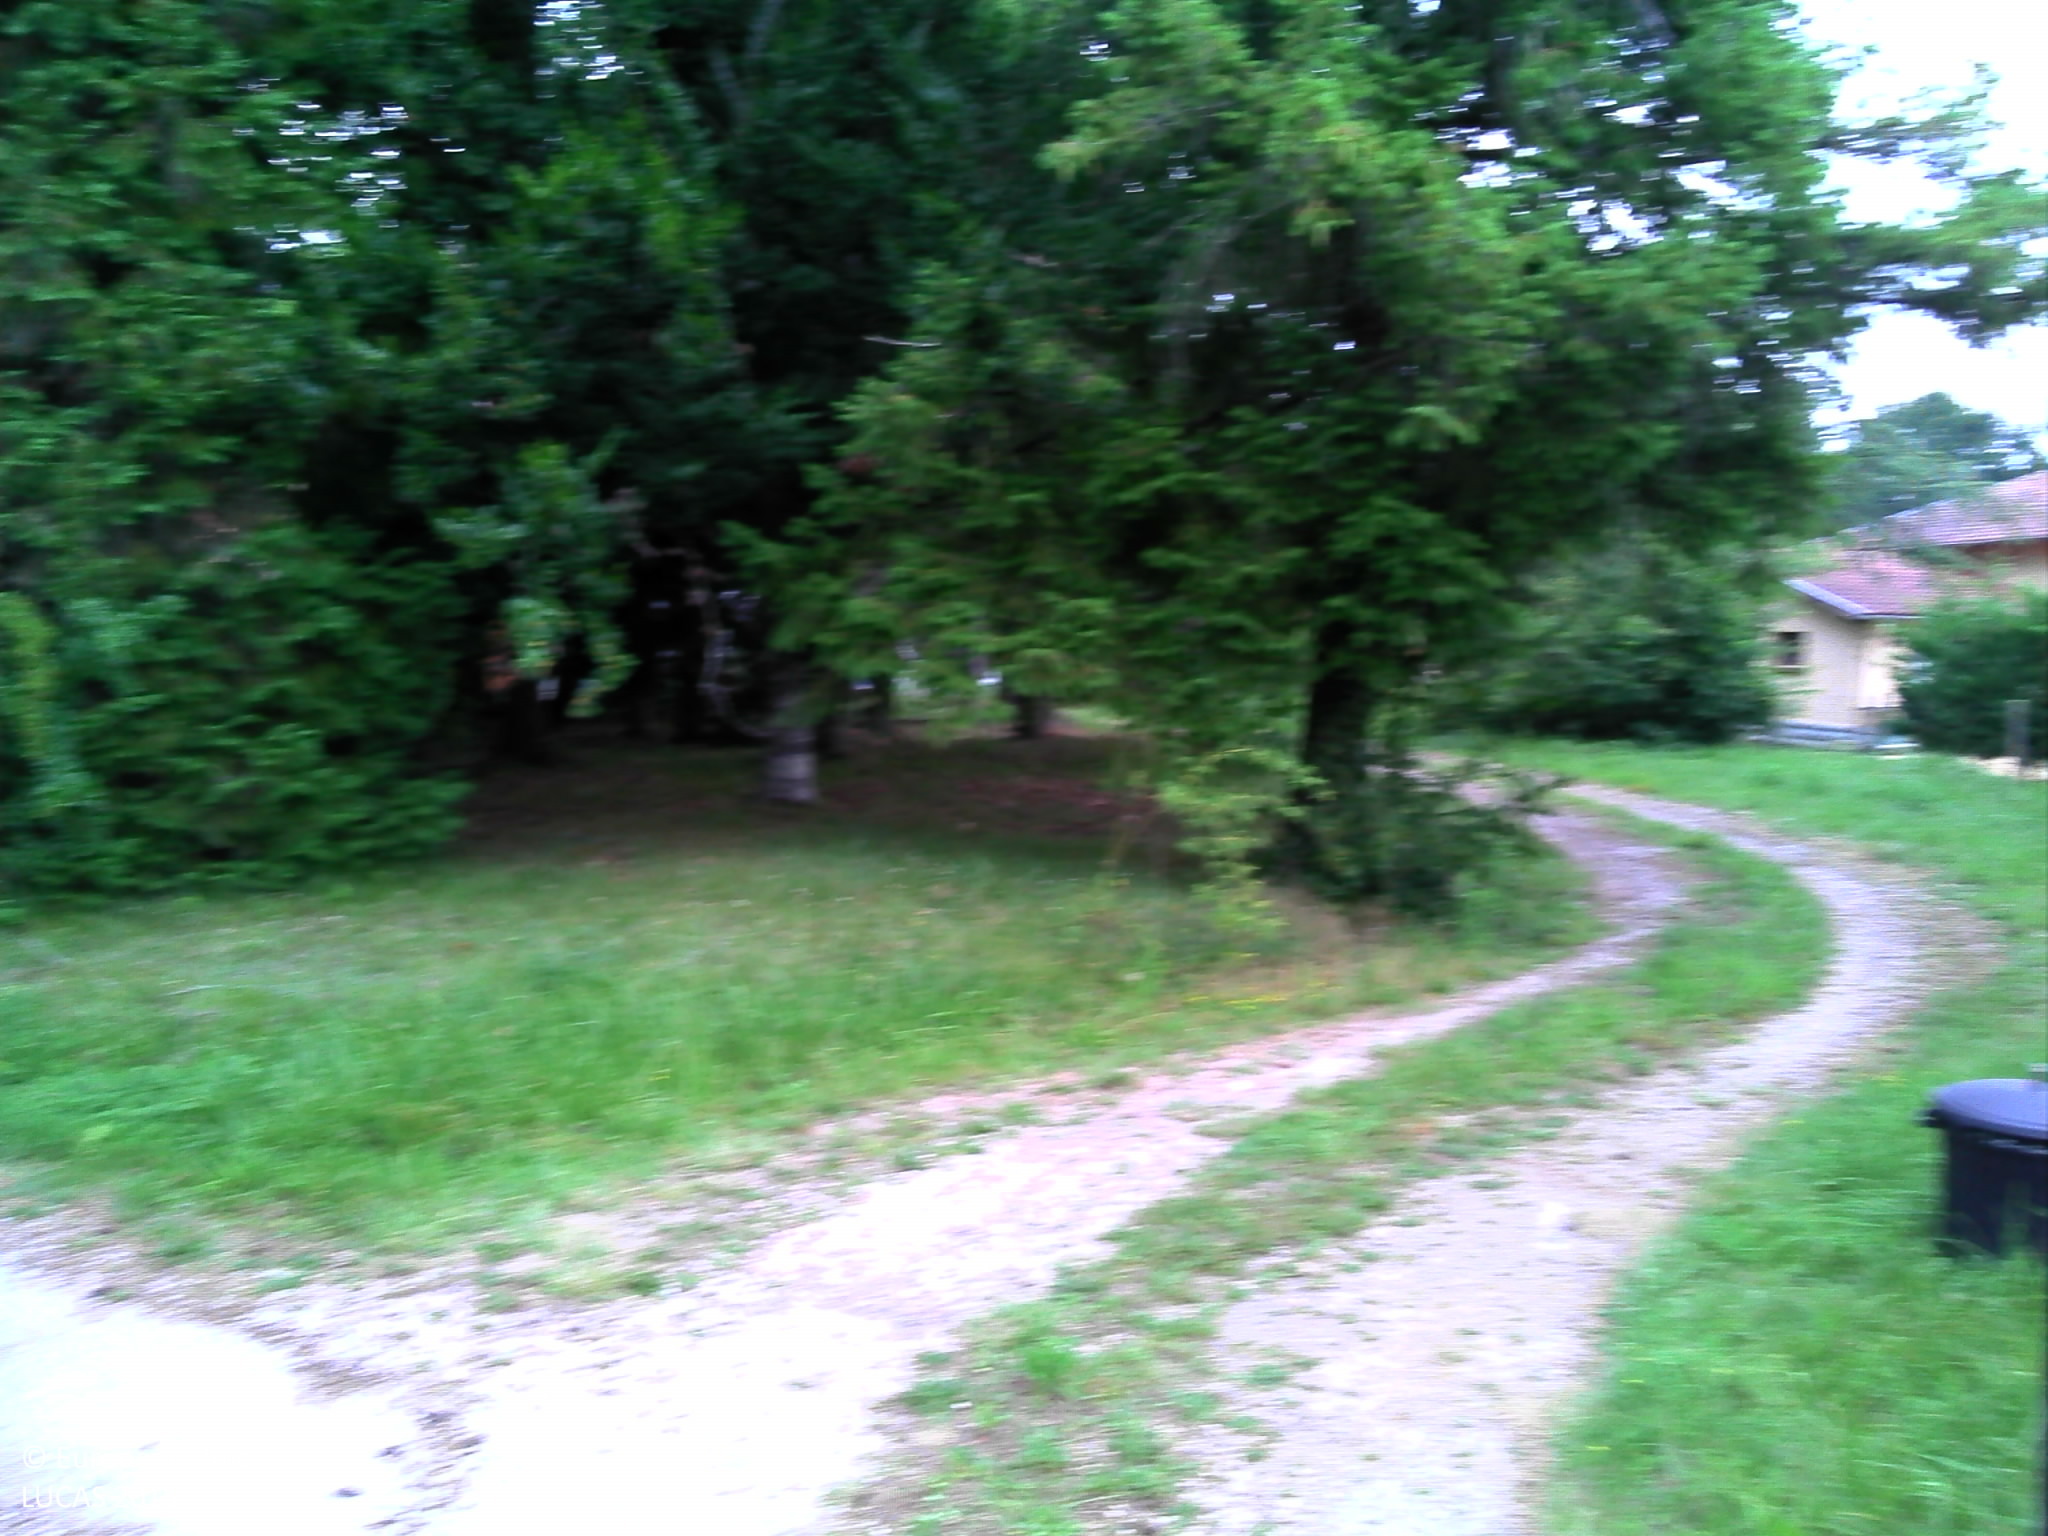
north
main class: Woodland
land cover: Spruce dominated mixed woodland
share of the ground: > 75 %
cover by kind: broadleaved forest trees 50 %, coniferous forest trees 30 %, shrubs 10 %, herbaceous plants 10 %
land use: Residential
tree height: > 5 m
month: July
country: FR
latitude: 43.1218
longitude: 0.7715
